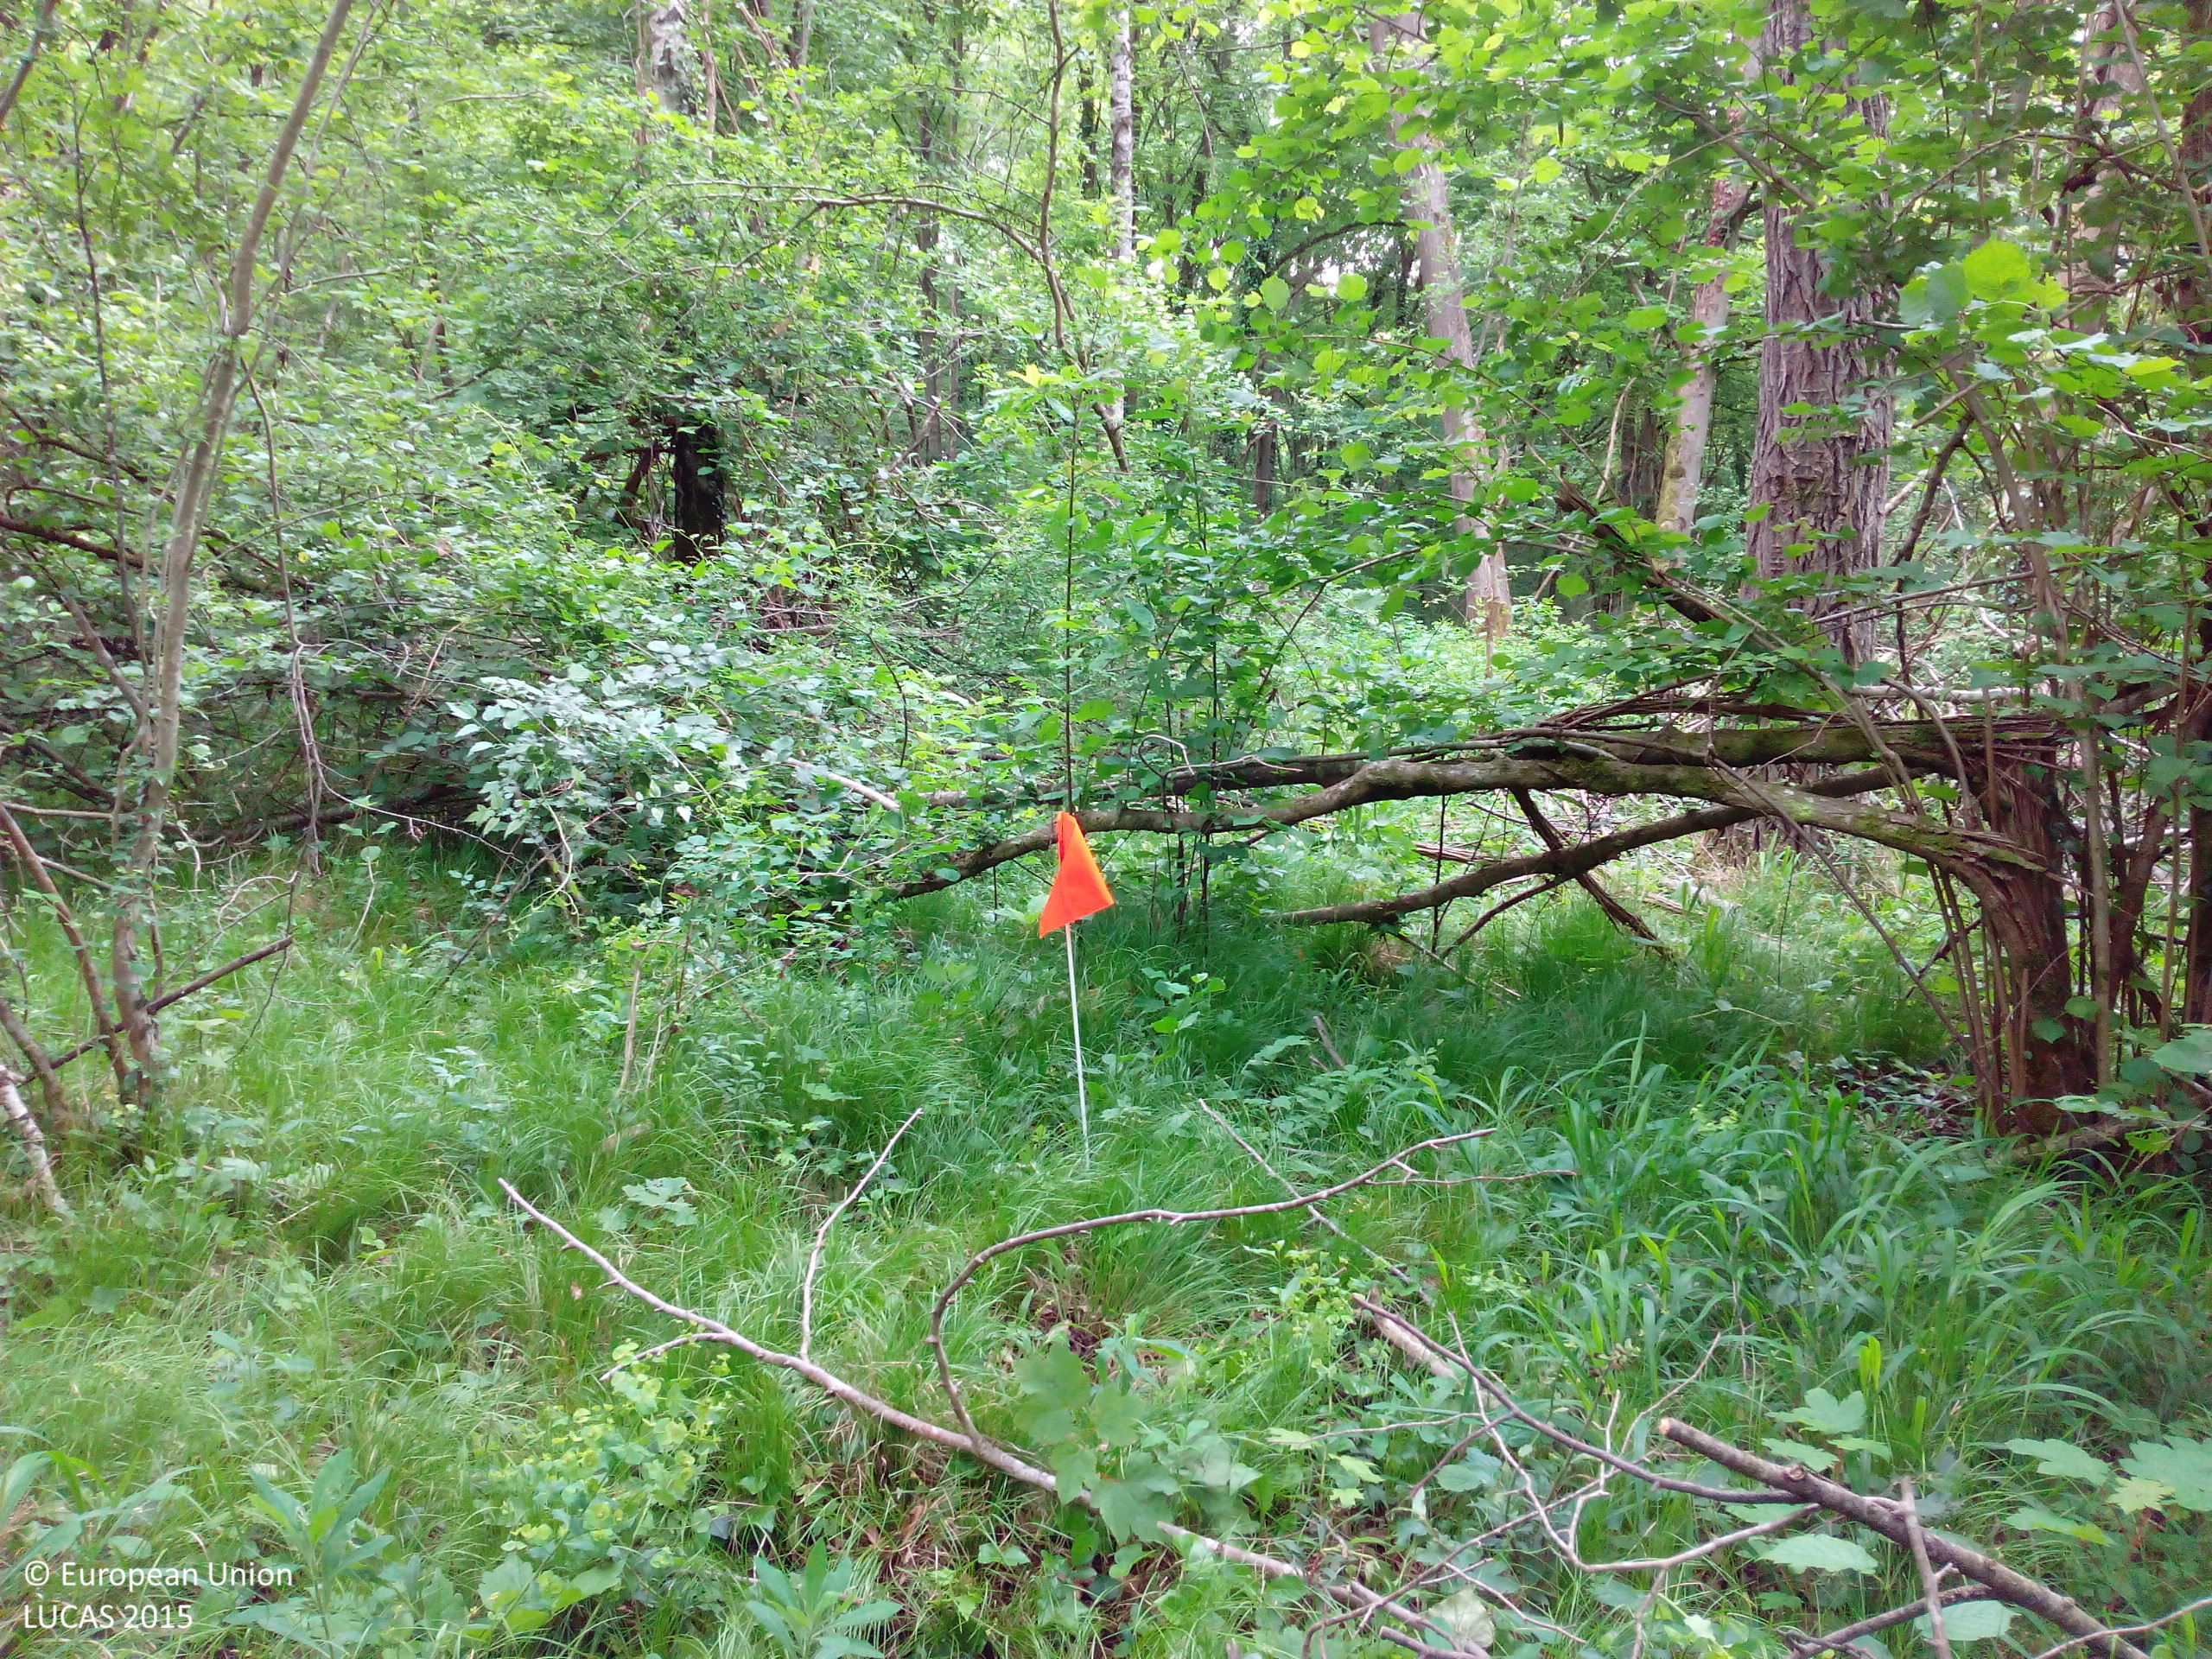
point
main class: Woodland
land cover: Broadleaved woodland
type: floodplain forest
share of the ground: > 75 %
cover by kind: broadleaved forest trees 85 %, shrubs 10 %, herbaceous plants 5 %
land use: Forestry
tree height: > 5 m
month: May
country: DE
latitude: 47.9641
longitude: 7.6306
